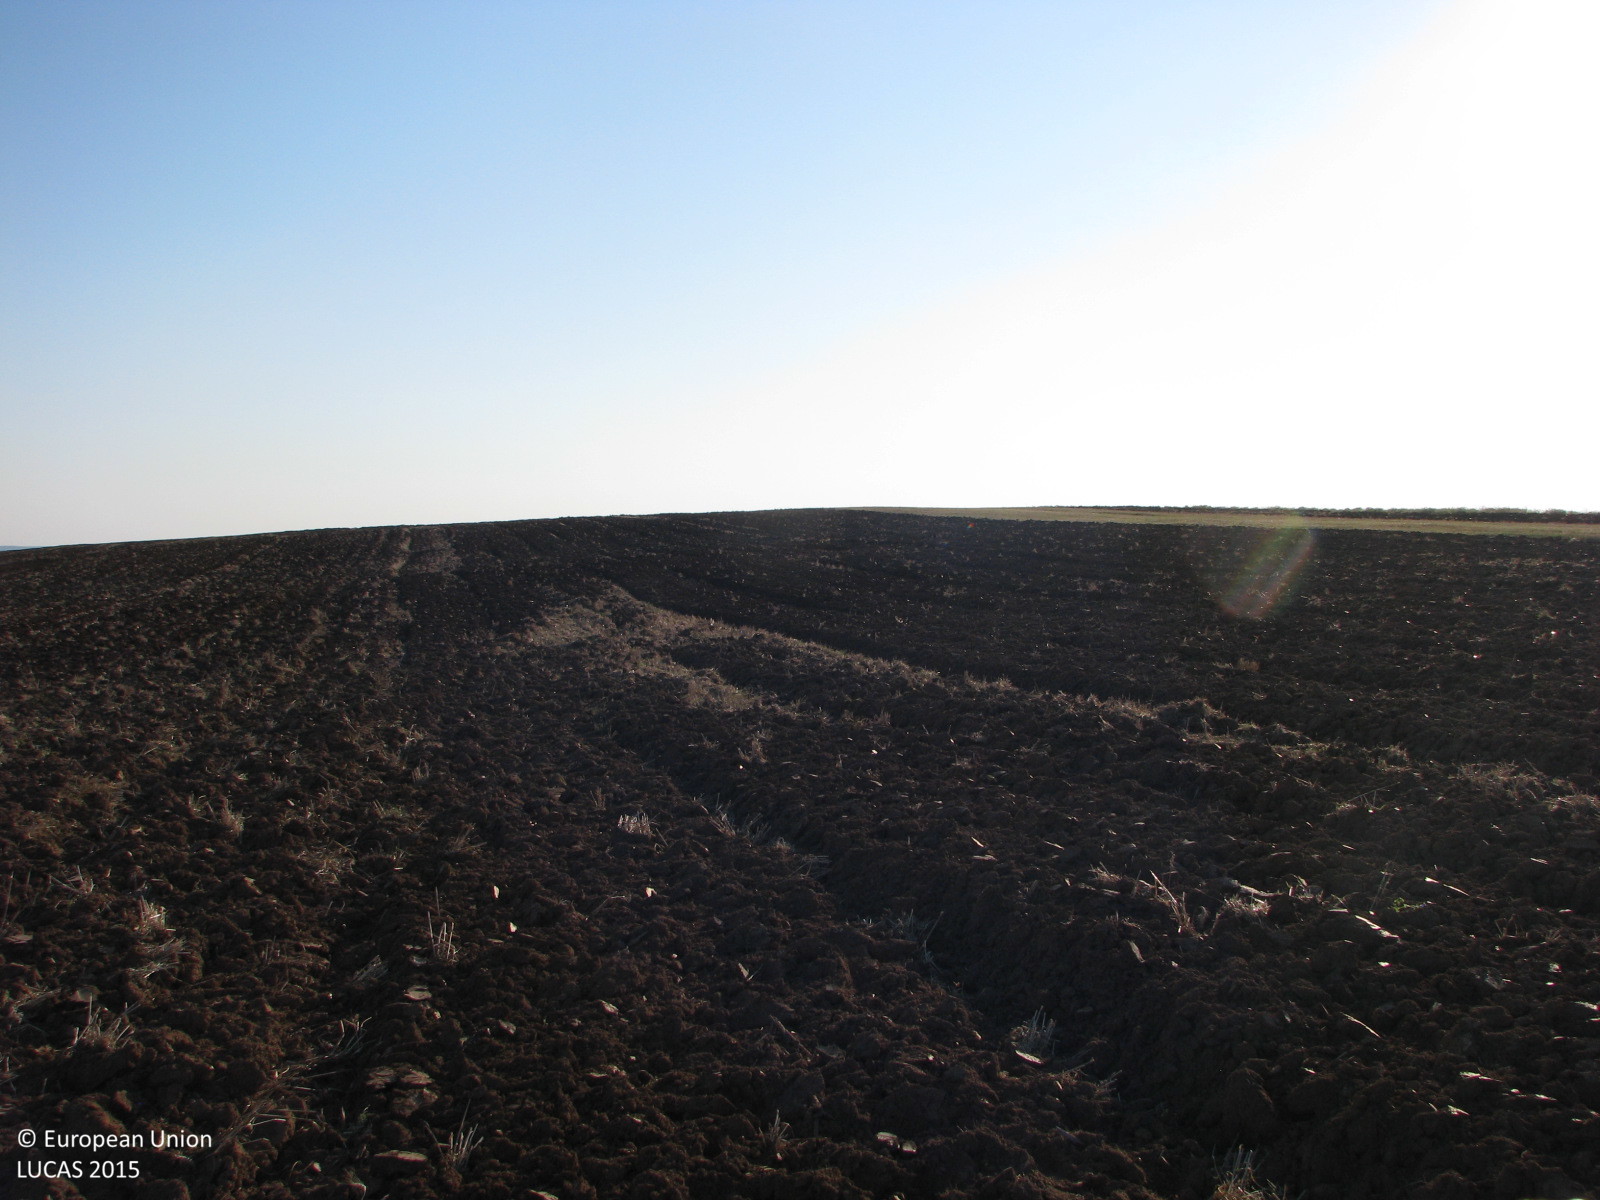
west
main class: Cropland
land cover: Common wheat
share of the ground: < 10 %
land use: Agriculture (excluding fallow land and kitchen gardens)
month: July
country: BG
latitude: 42.2079
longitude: 26.9475
